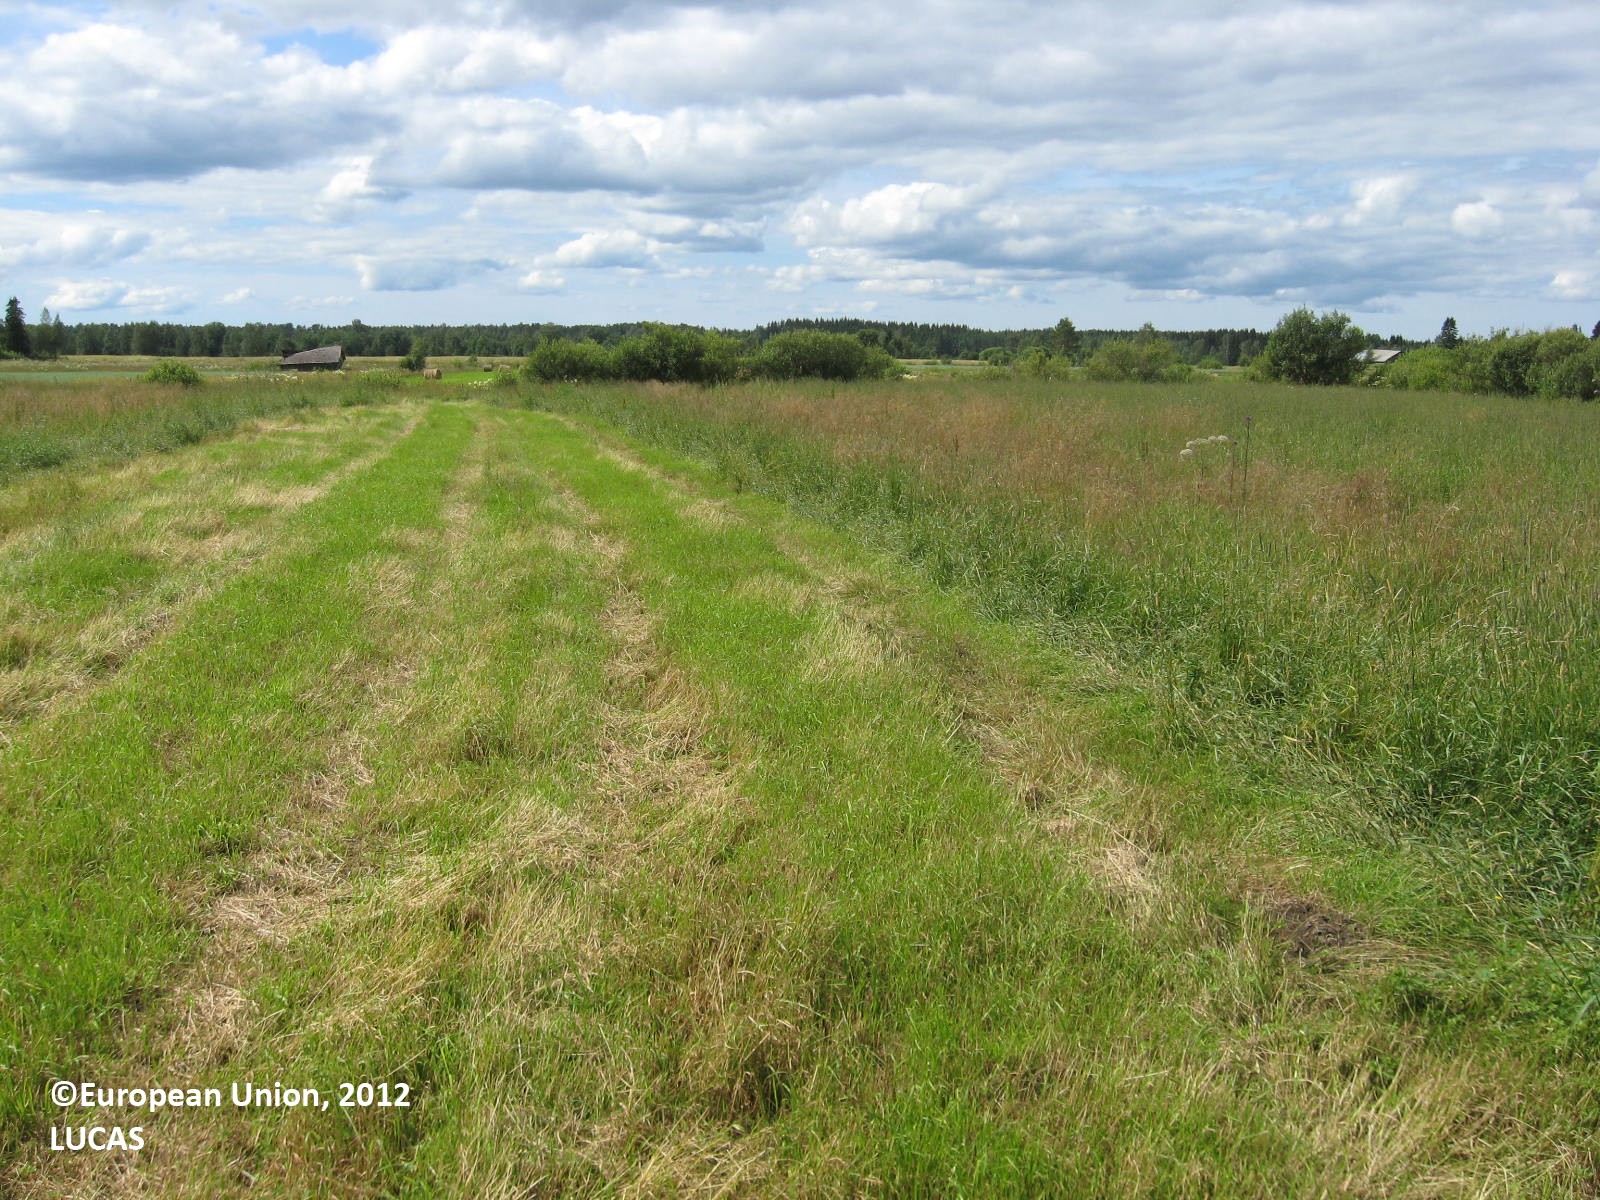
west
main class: Cropland
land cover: Temporary grasslands
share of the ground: > 75 %
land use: Agriculture (excluding fallow land and kitchen gardens)
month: July
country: FI
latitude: 62.0528
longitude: 22.2783
